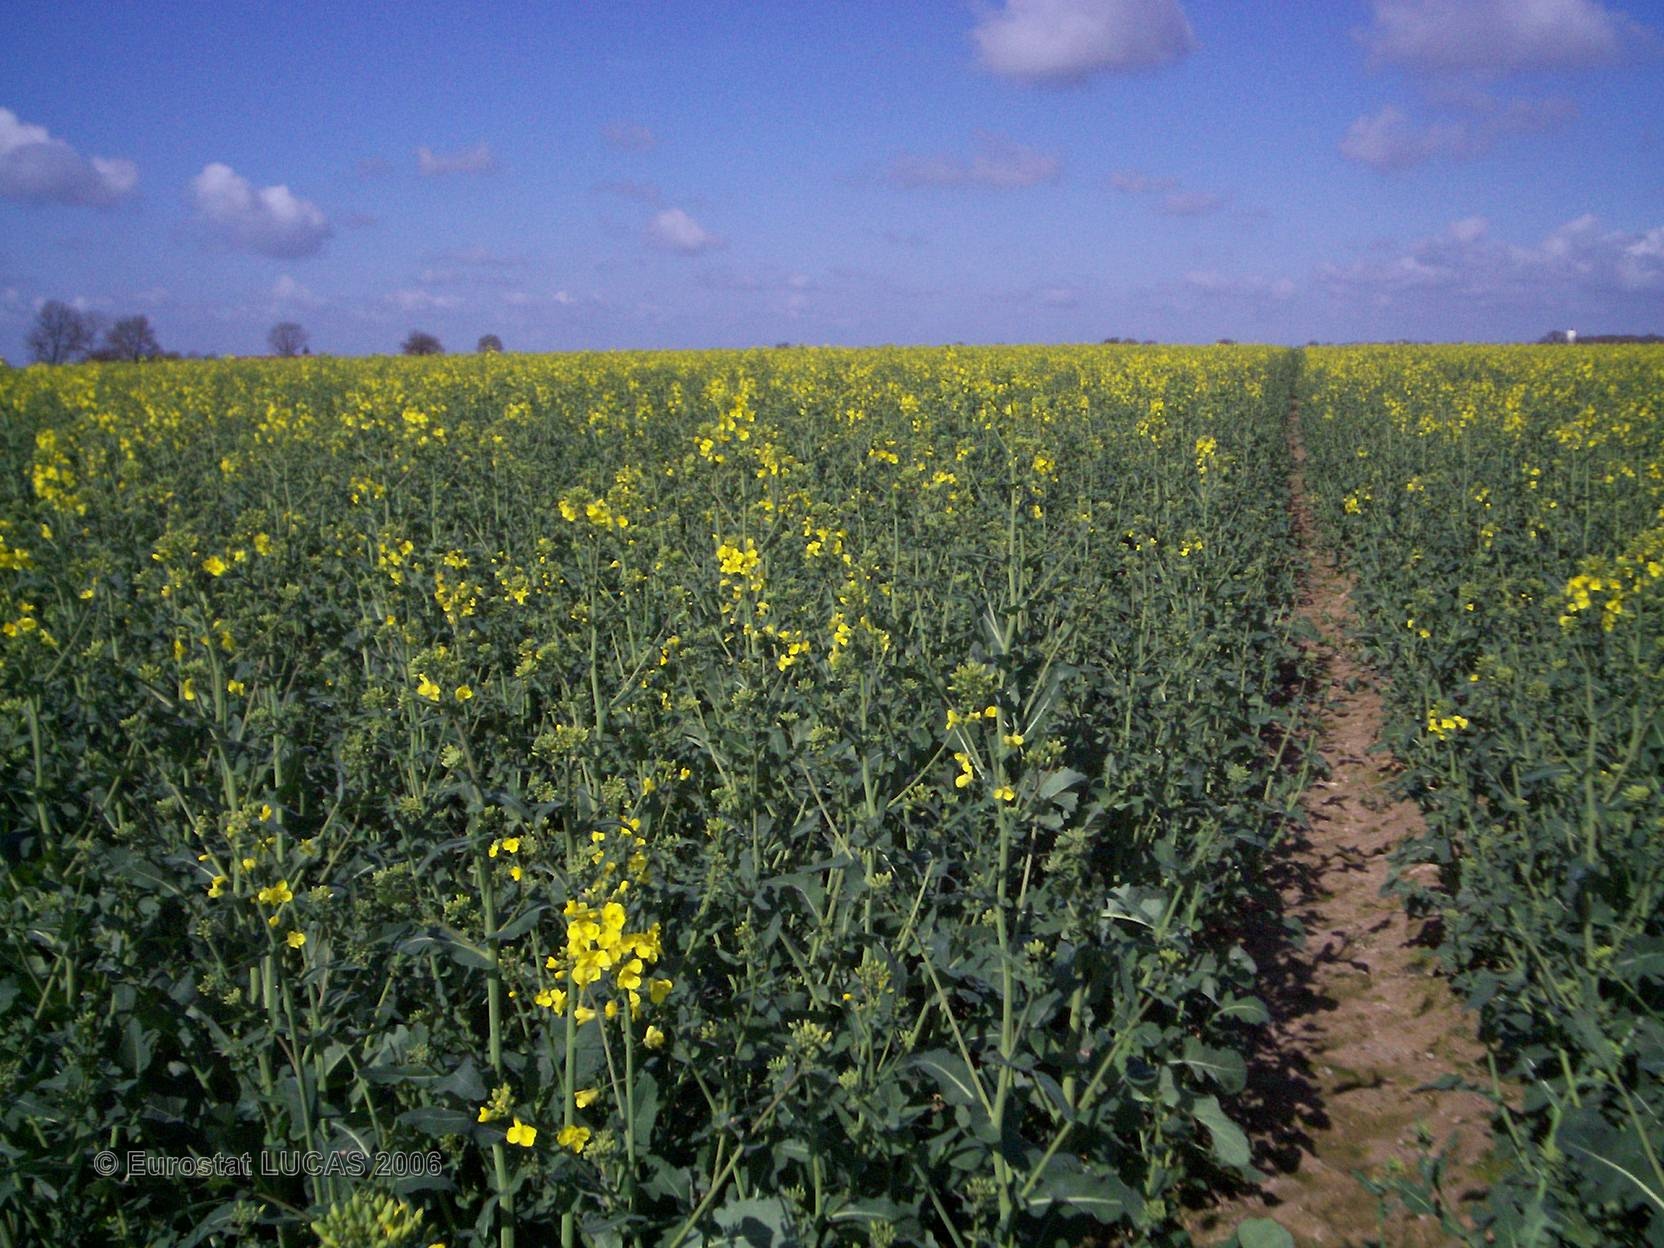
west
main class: Cropland
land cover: Rape and turnip rape
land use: Agriculture (excluding fallow land and kitchen gardens)
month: April
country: FR
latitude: 47.0017
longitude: 0.9754
